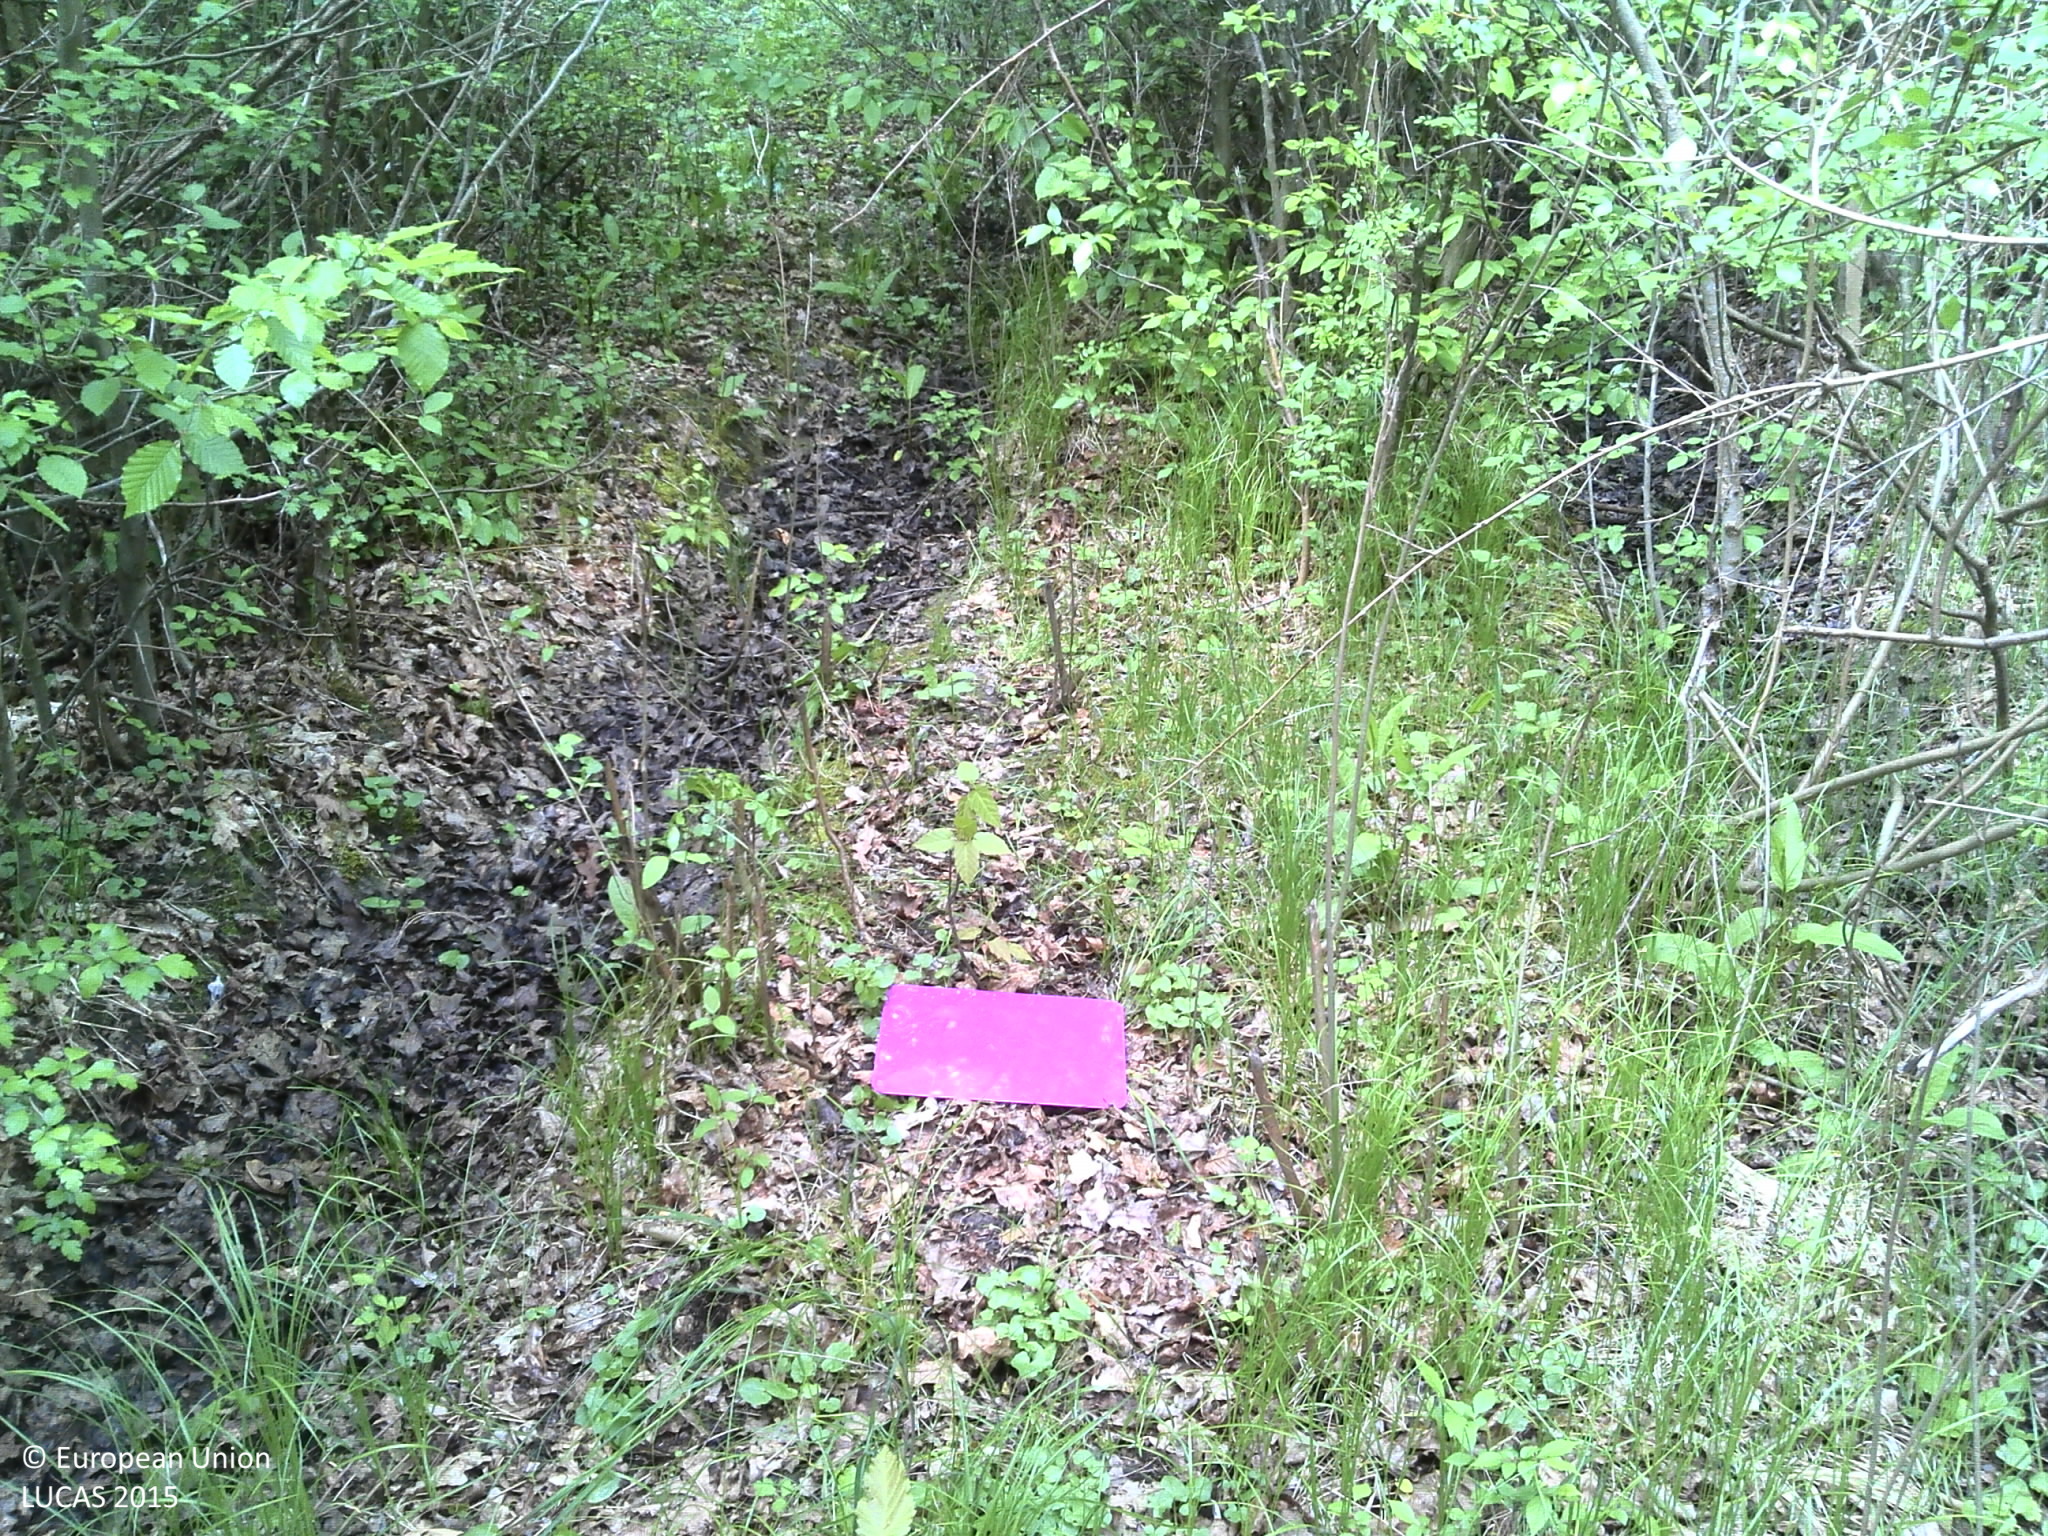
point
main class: Woodland
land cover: Broadleaved woodland
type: mesophytic deciduous forest
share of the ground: > 75 %
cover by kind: broadleaved forest trees 90 %, shrubs 10 %
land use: Forestry
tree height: < 5 m
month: April
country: HR
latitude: 45.0439
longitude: 19.0341
